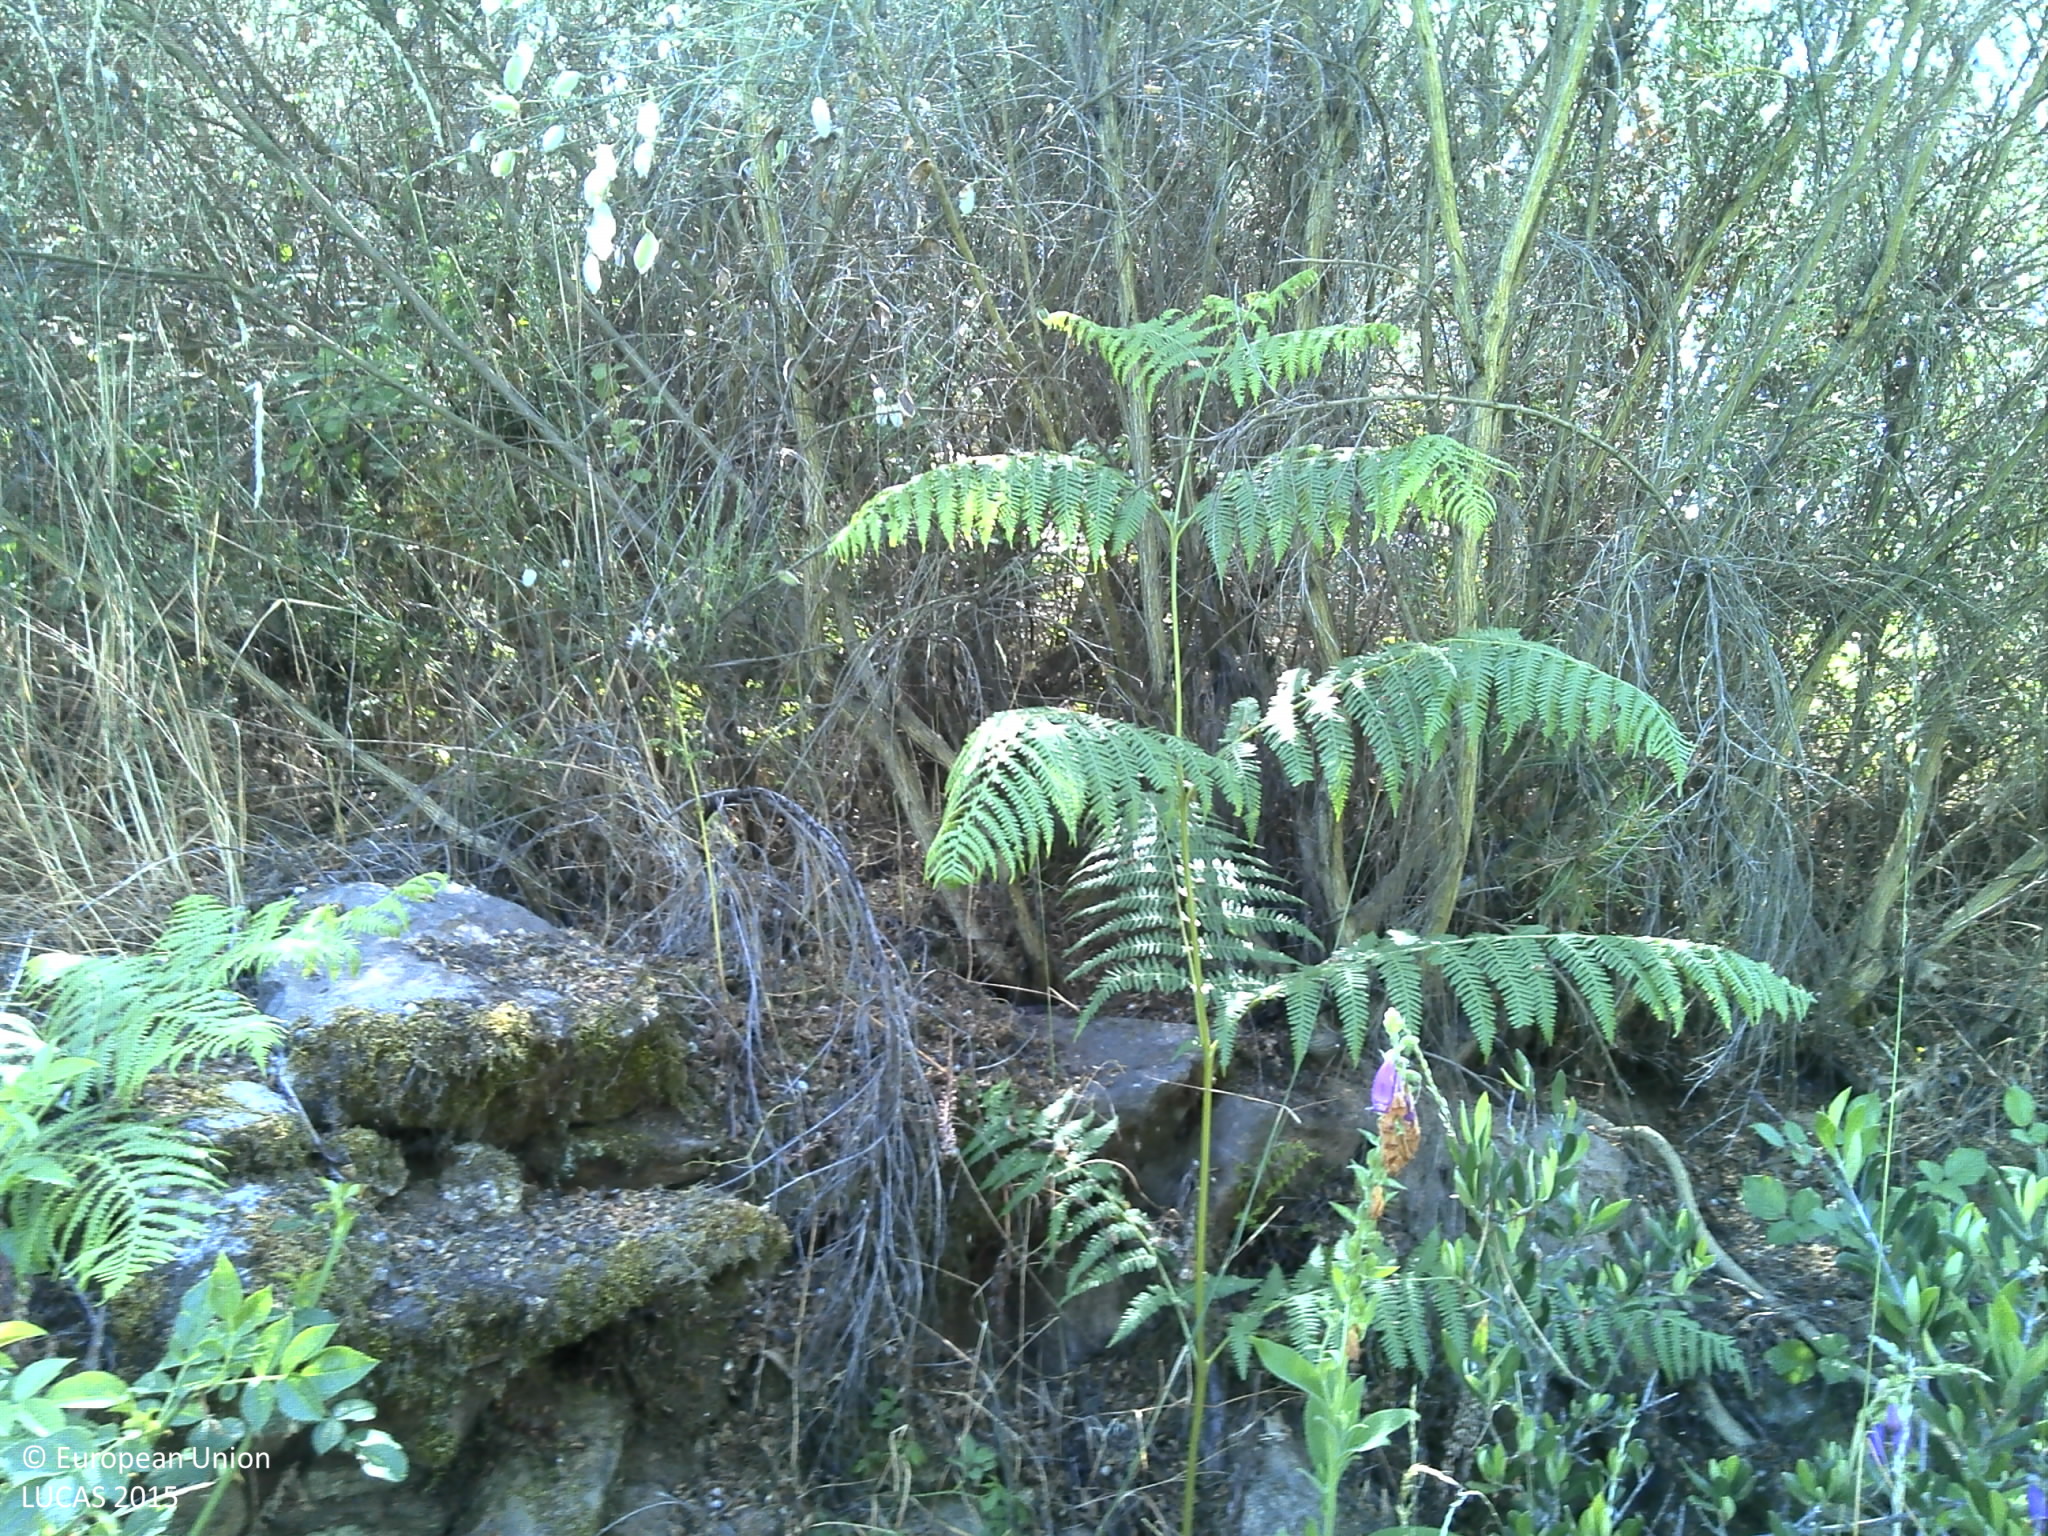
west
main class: Shrubland
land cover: Shrubland with sparse tree cover
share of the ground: > 75 %
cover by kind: shrubs 95 %, coniferous forest trees 5 %
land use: Semi-natural and natural areas not in use
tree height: > 5 m
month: June
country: PT
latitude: 41.0384
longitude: -7.5235
